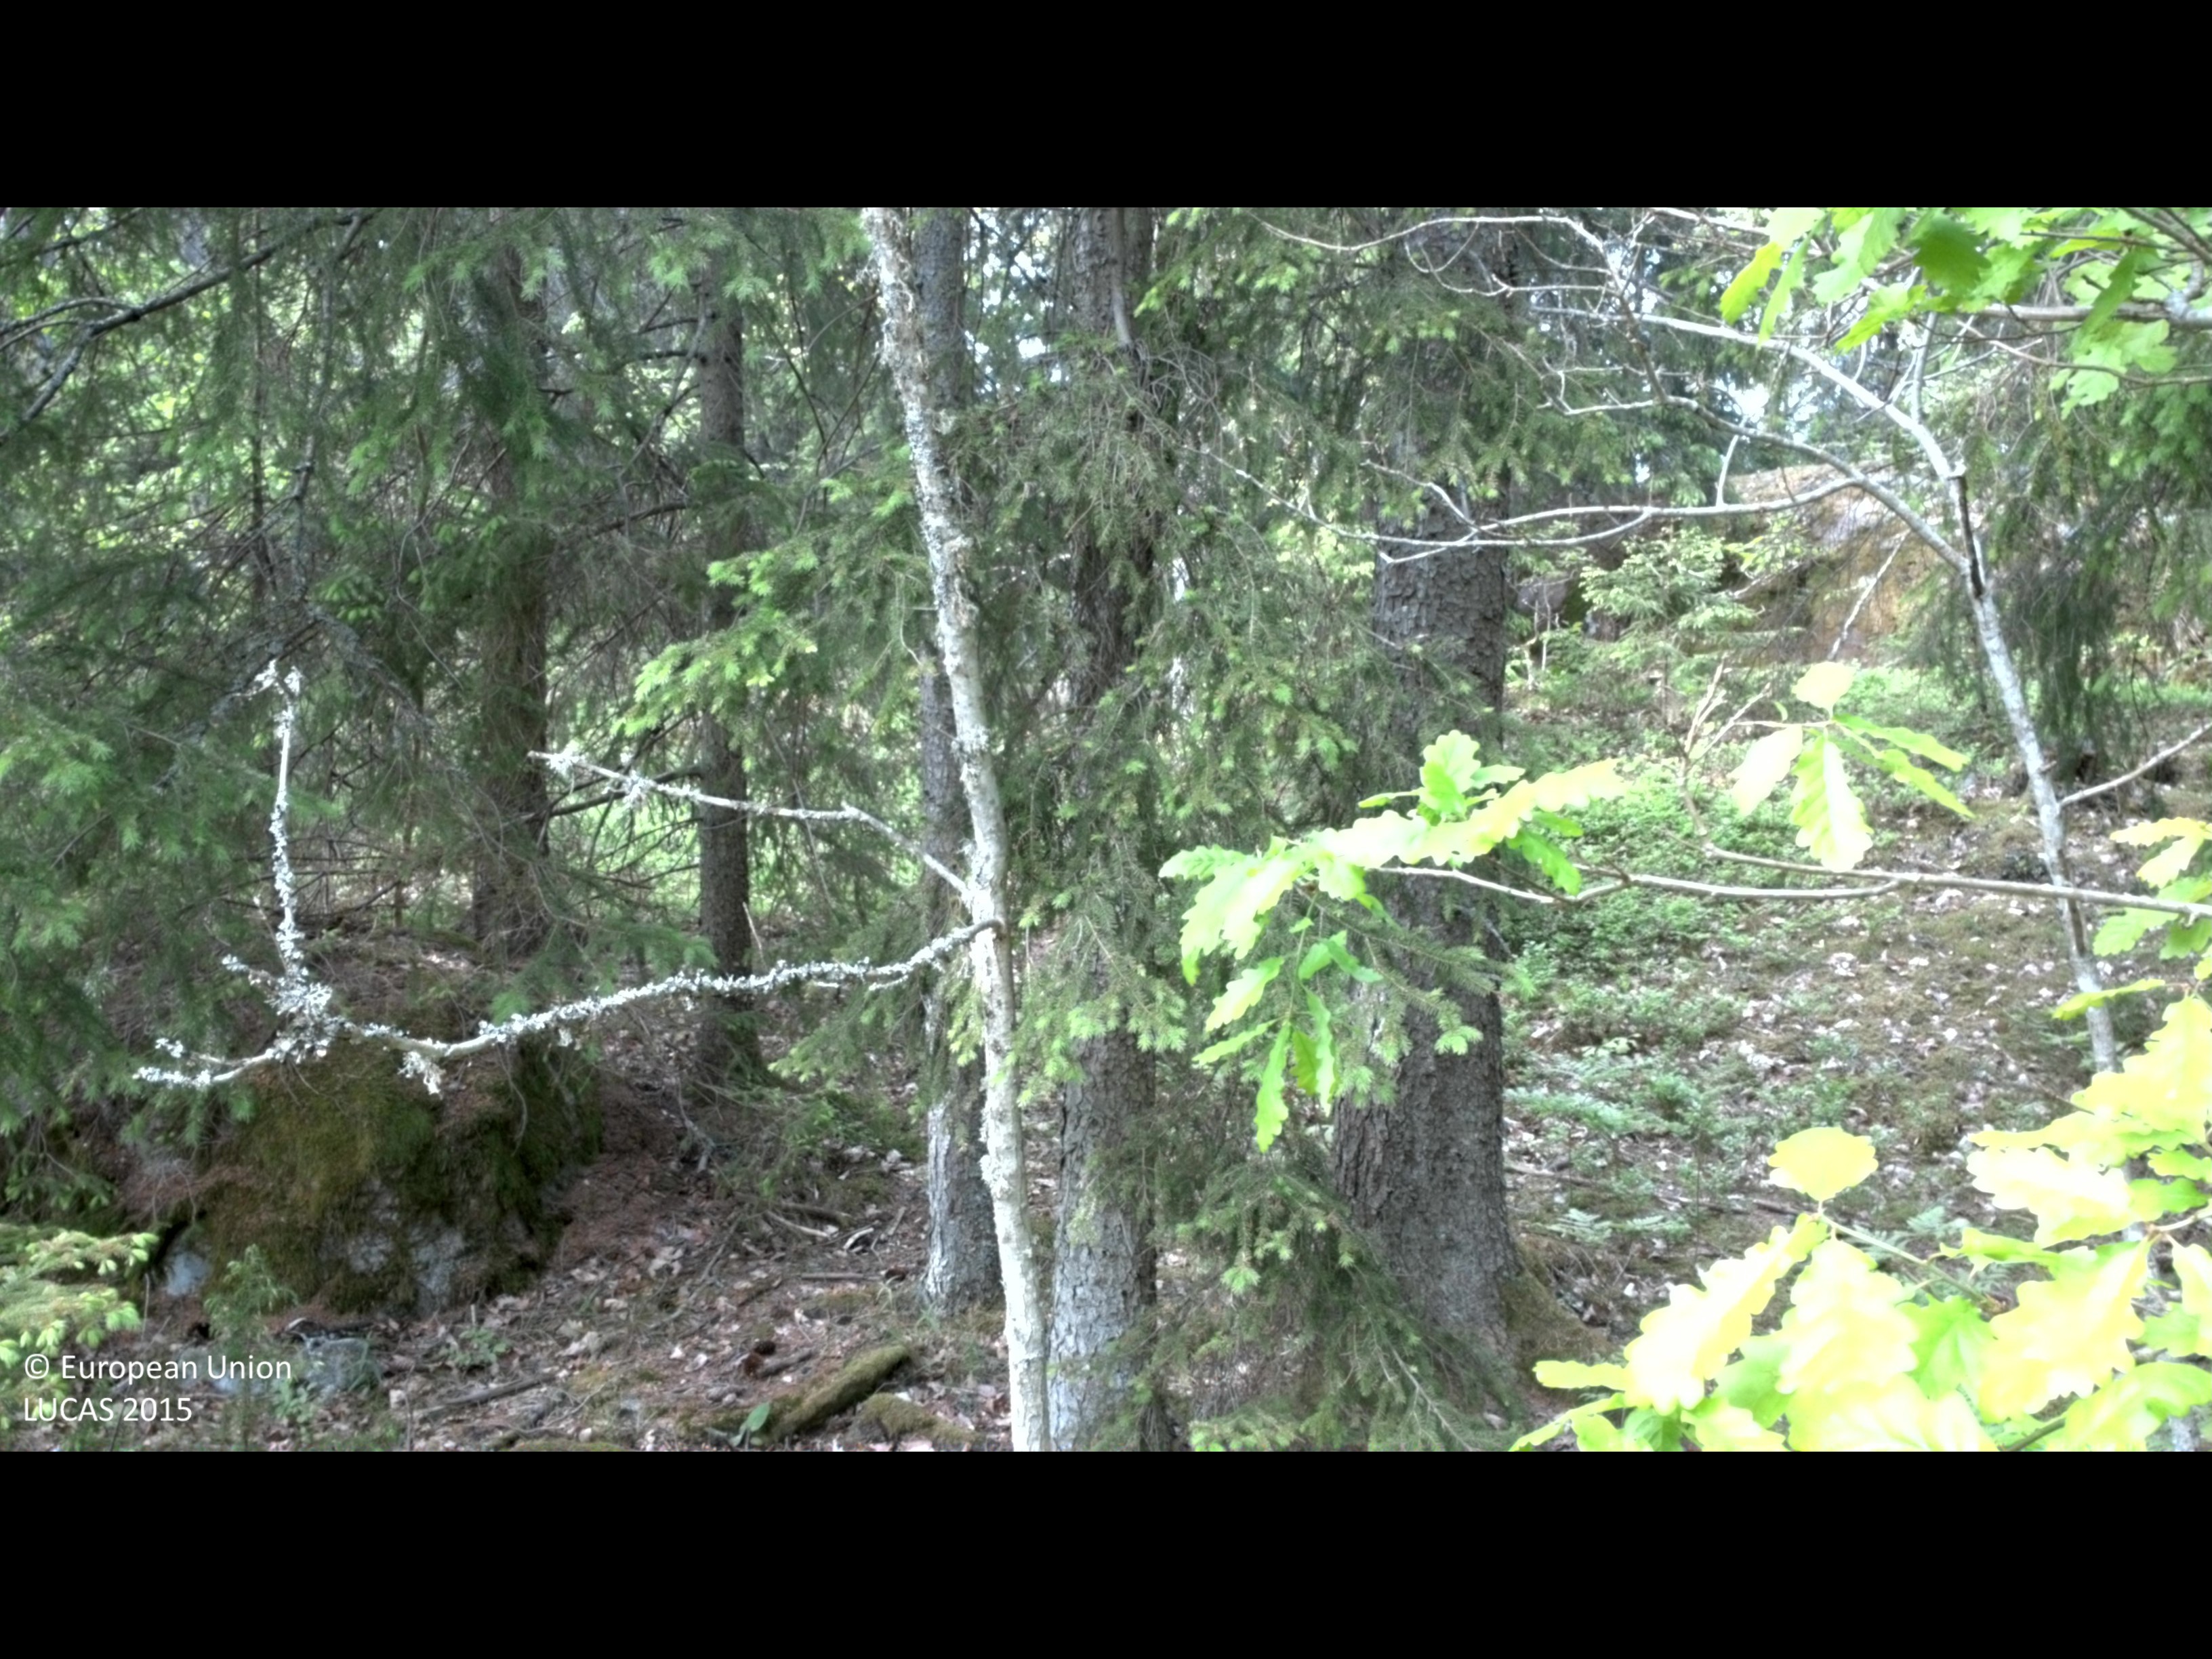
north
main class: Woodland
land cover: Spruce dominated mixed woodland
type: boreal forest
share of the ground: > 75 %
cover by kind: coniferous forest trees 45 %, broadleaved forest trees 40 %, shrubs 10 %, consolidated bare surface 5 %
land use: Forestry
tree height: > 5 m
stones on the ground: 10 - 25 %
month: May
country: SE
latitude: 57.4852
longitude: 16.4879
